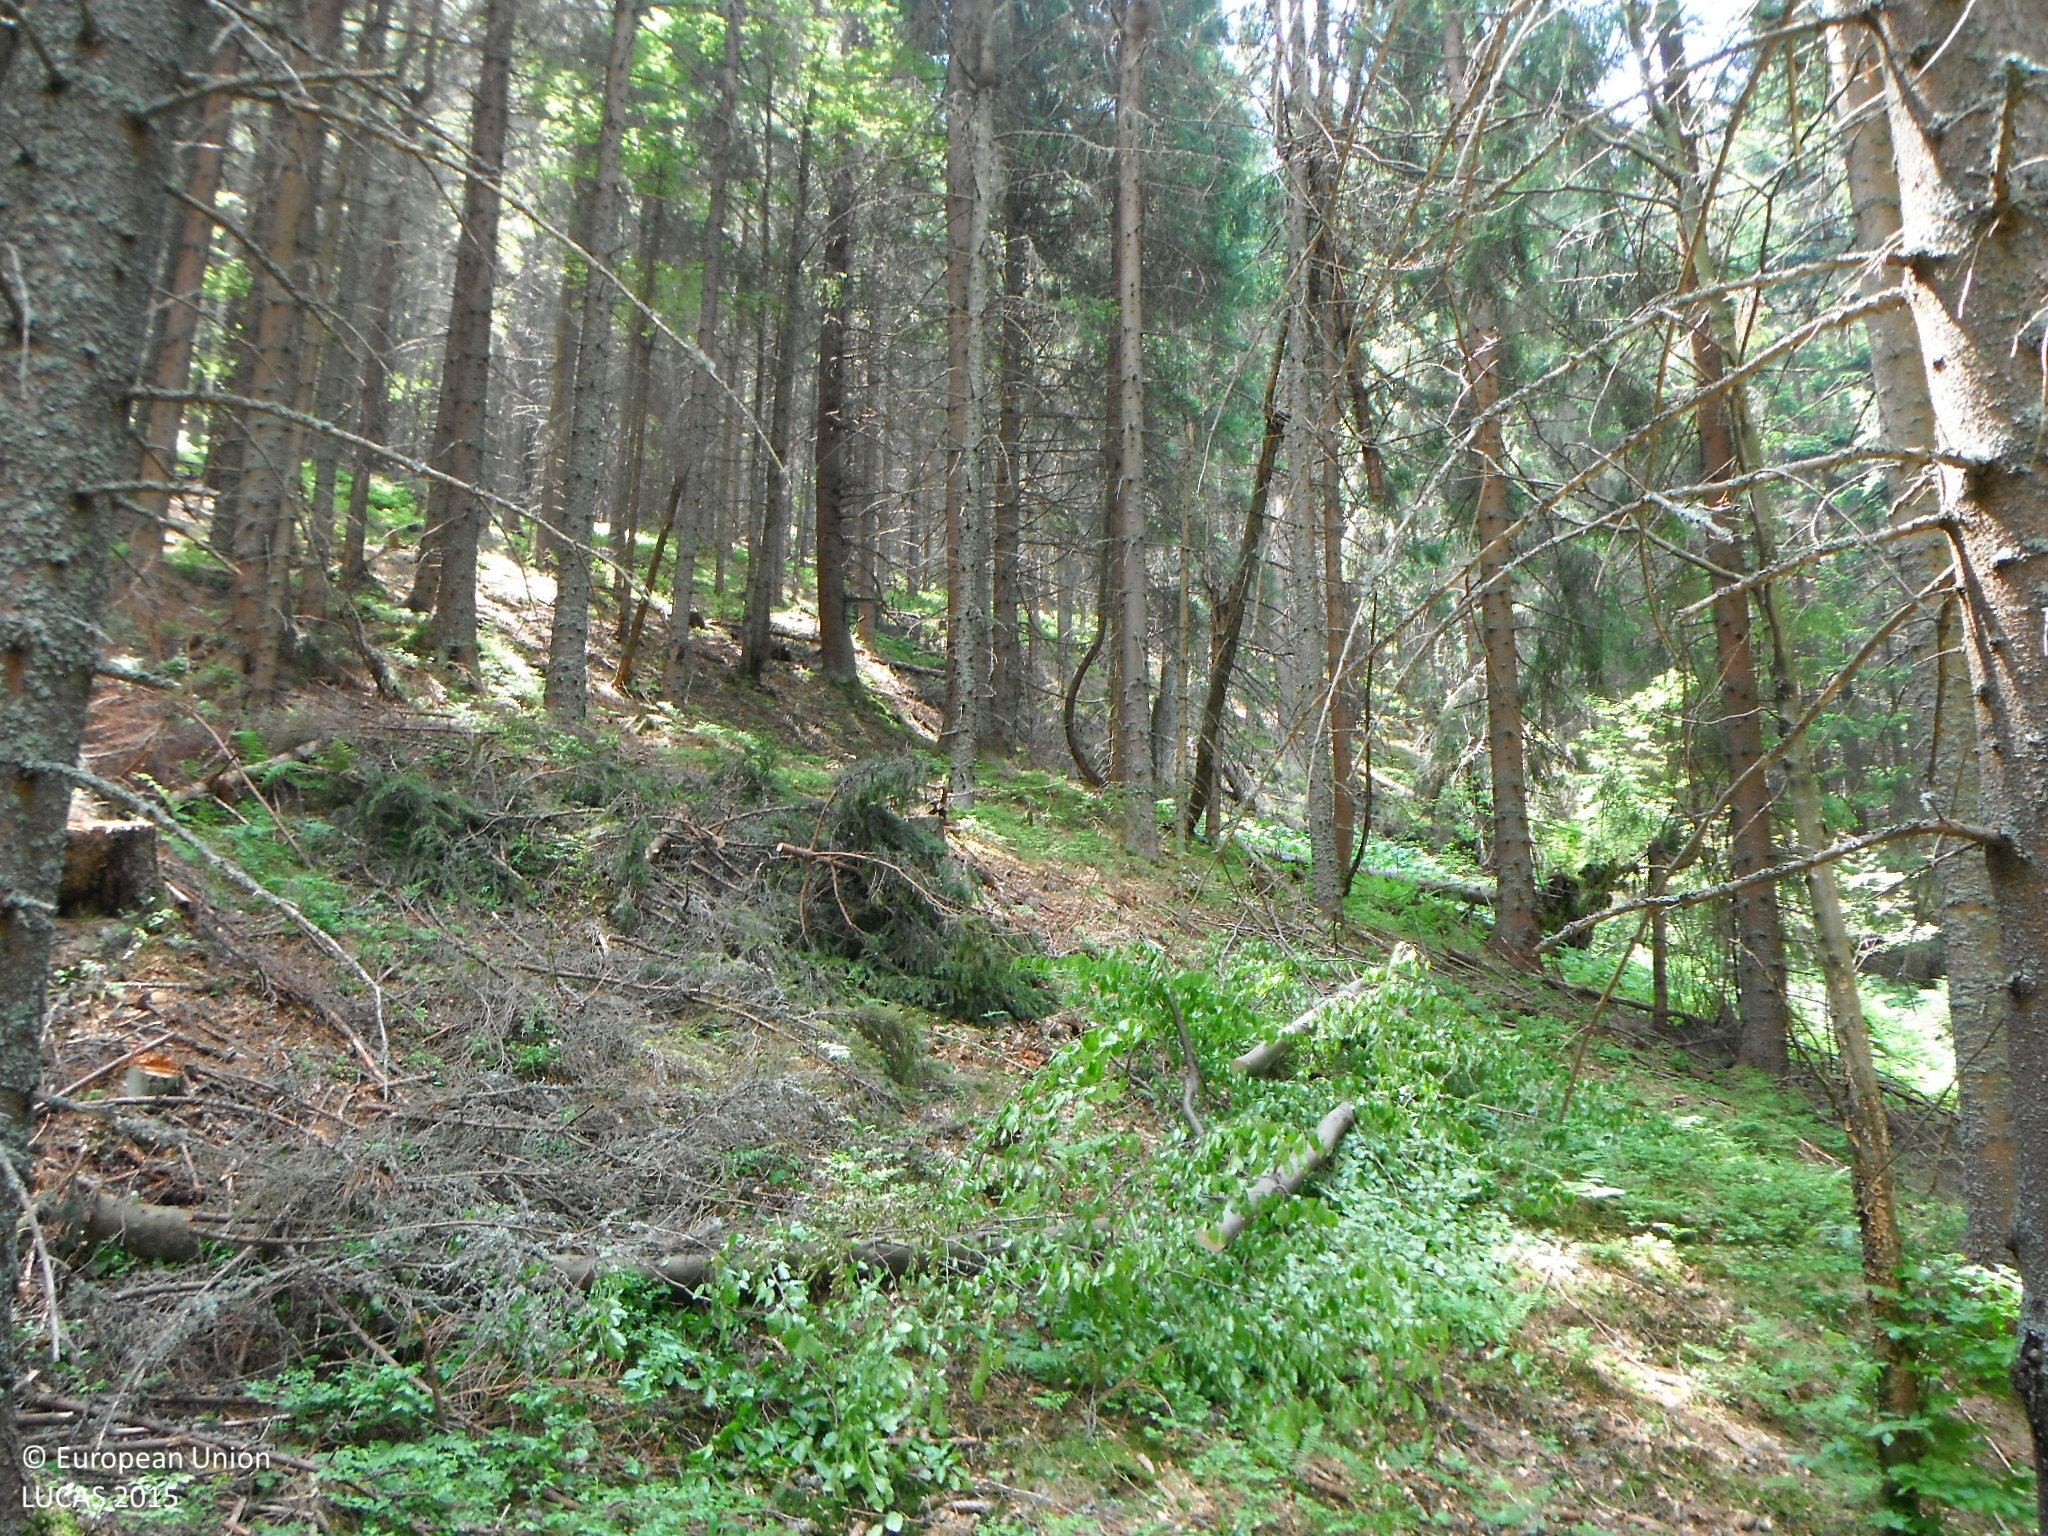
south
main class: Woodland
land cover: Spruce dominated coniferous woodland
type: alpine coniferous forest
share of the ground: > 75 %
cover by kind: coniferous forest trees 90 %, herbaceous plants 10 %
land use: Forestry
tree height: > 5 m
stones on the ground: < 10 %
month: June
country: SK
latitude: 48.9413
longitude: 19.4320
